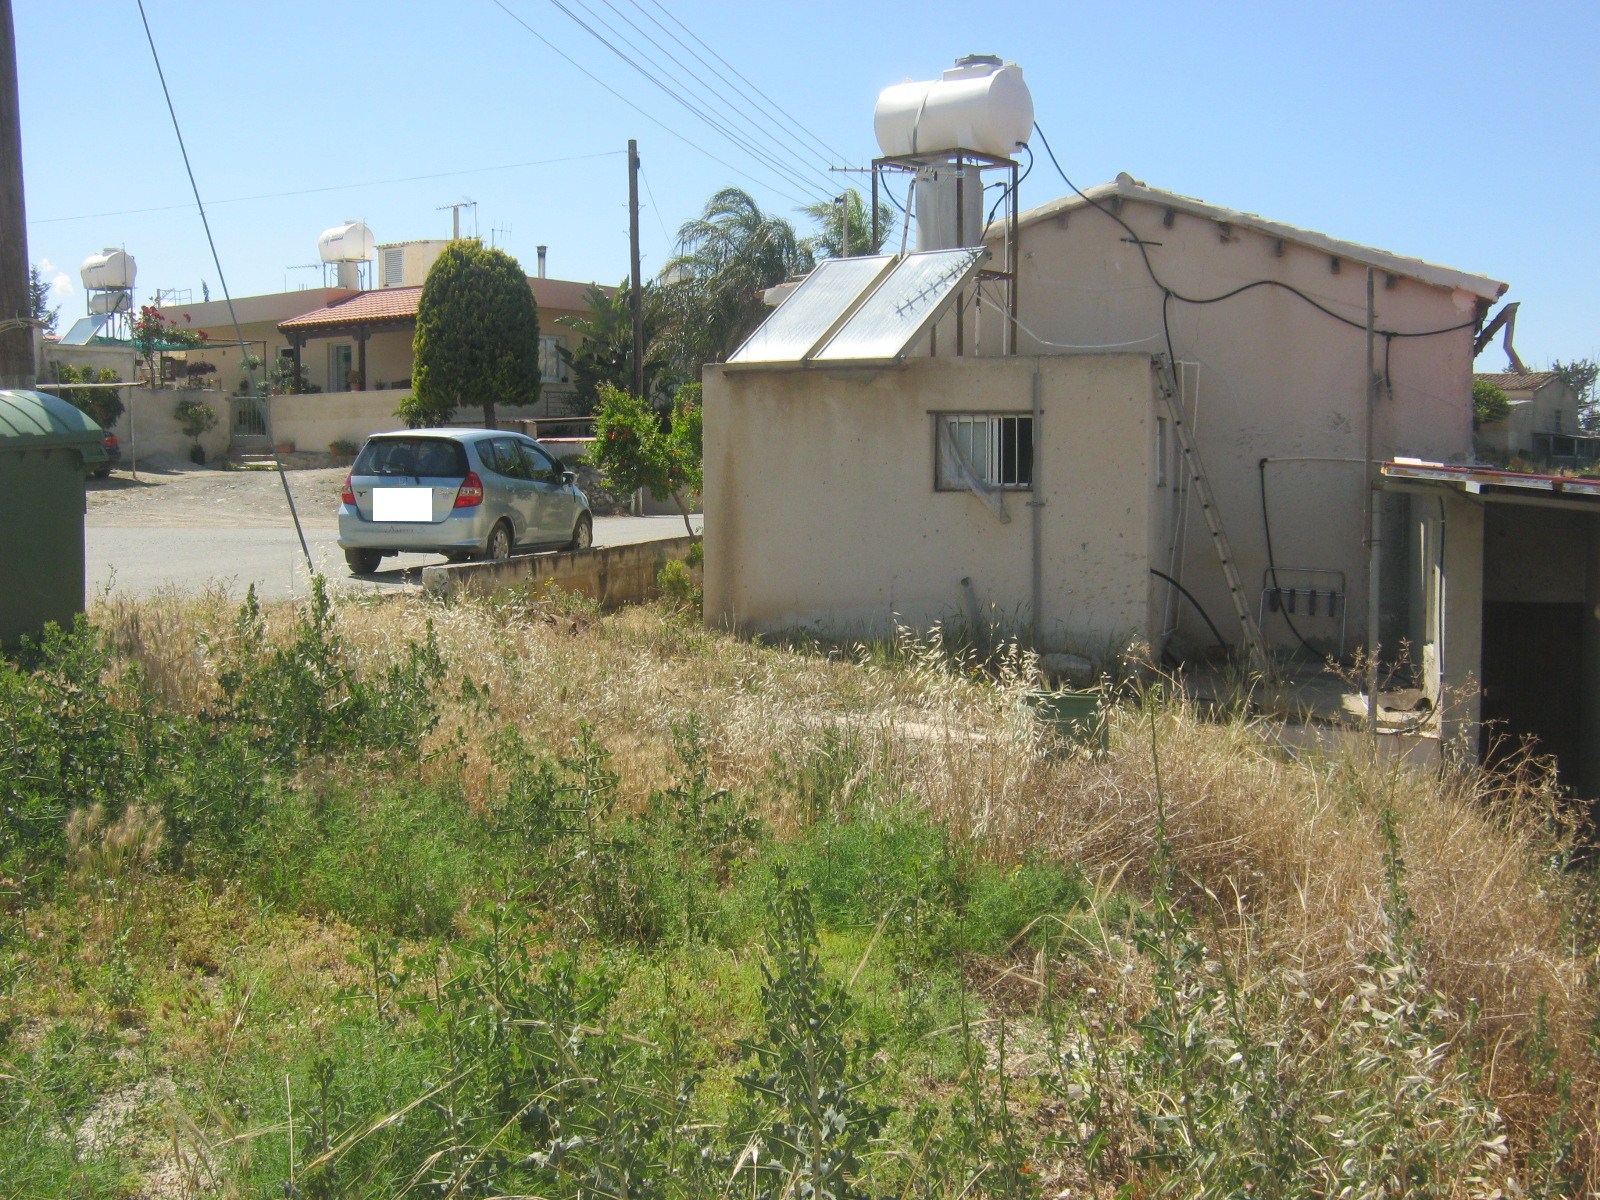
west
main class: Grassland
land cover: Grassland without tree/shrub cover
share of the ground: > 75 %
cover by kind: herbaceous plants 100 %
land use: Residential
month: May
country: CY
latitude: 35.1049
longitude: 33.0307
